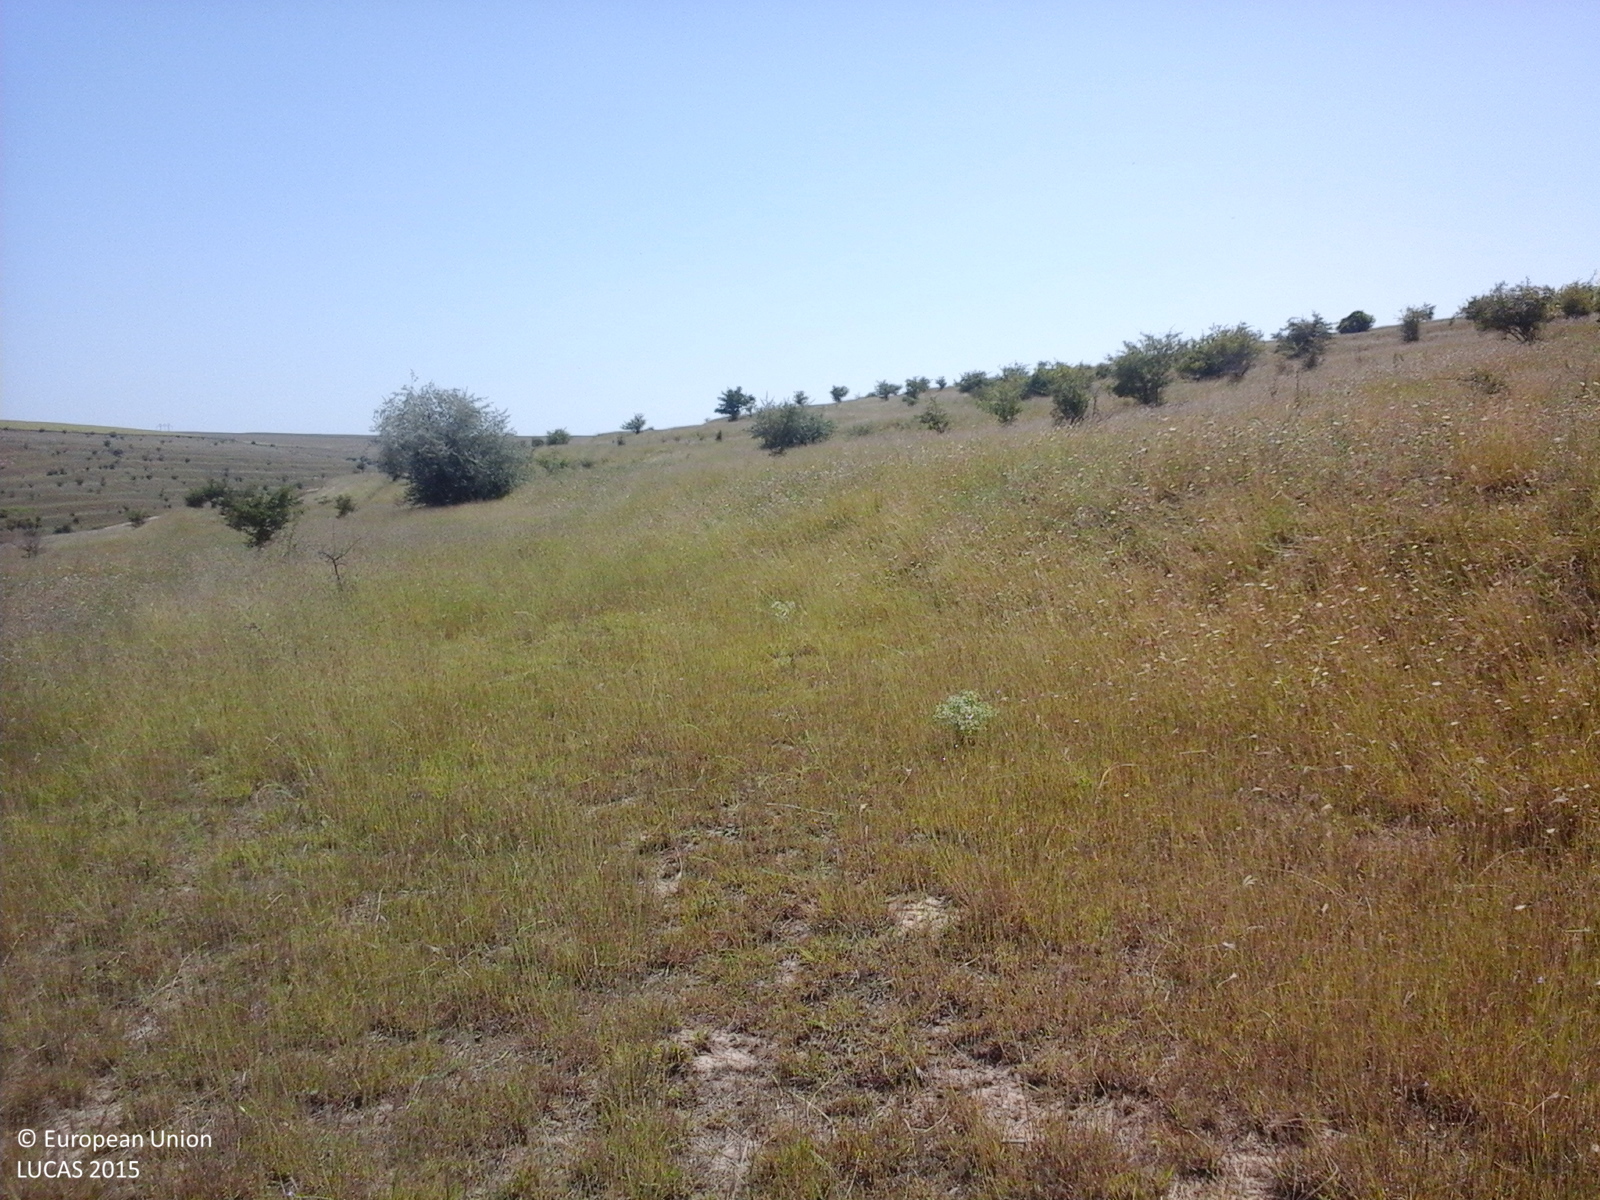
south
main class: Grassland
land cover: Grassland without tree/shrub cover
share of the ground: > 75 %
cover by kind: herbaceous plants 100 %
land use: Agriculture (excluding fallow land and kitchen gardens)
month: August
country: RO
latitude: 44.4329
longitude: 28.1384
